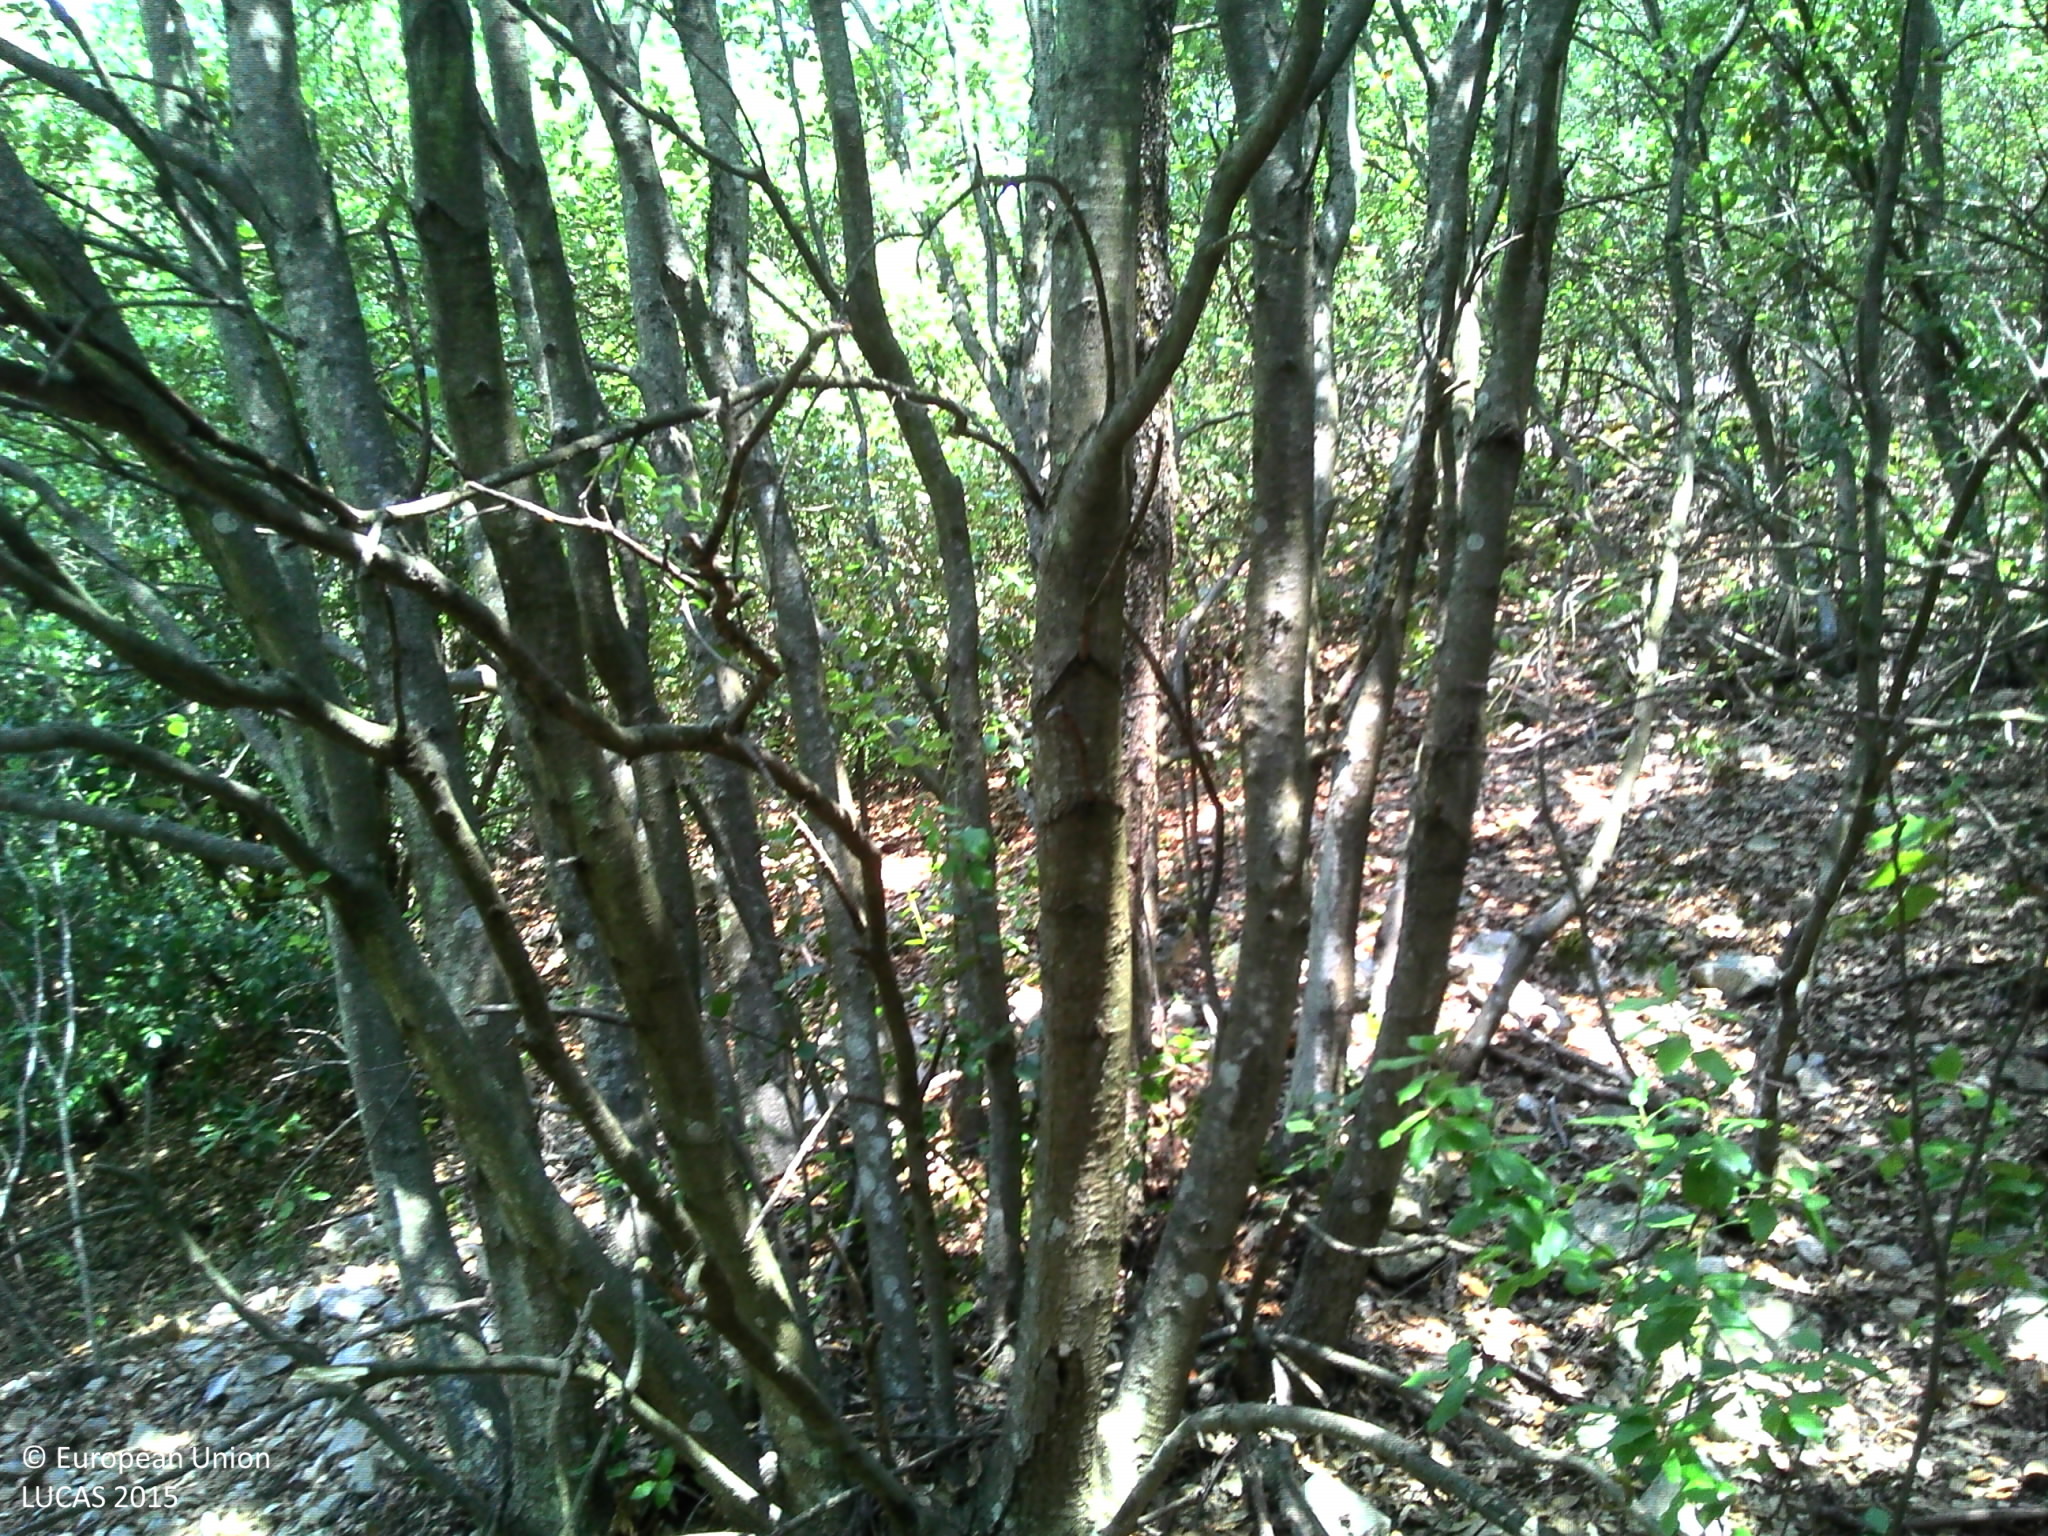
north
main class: Woodland
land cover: Broadleaved woodland
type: broadleaved evergreen forest
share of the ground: > 75 %
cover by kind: broadleaved forest trees 70 %, shrubs 15 %, coniferous forest trees 10 %, unconsolidated bare surface 5 %
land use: Semi-natural and natural areas not in use
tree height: > 5 m
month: July
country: FR
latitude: 44.0612
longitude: 5.2519
